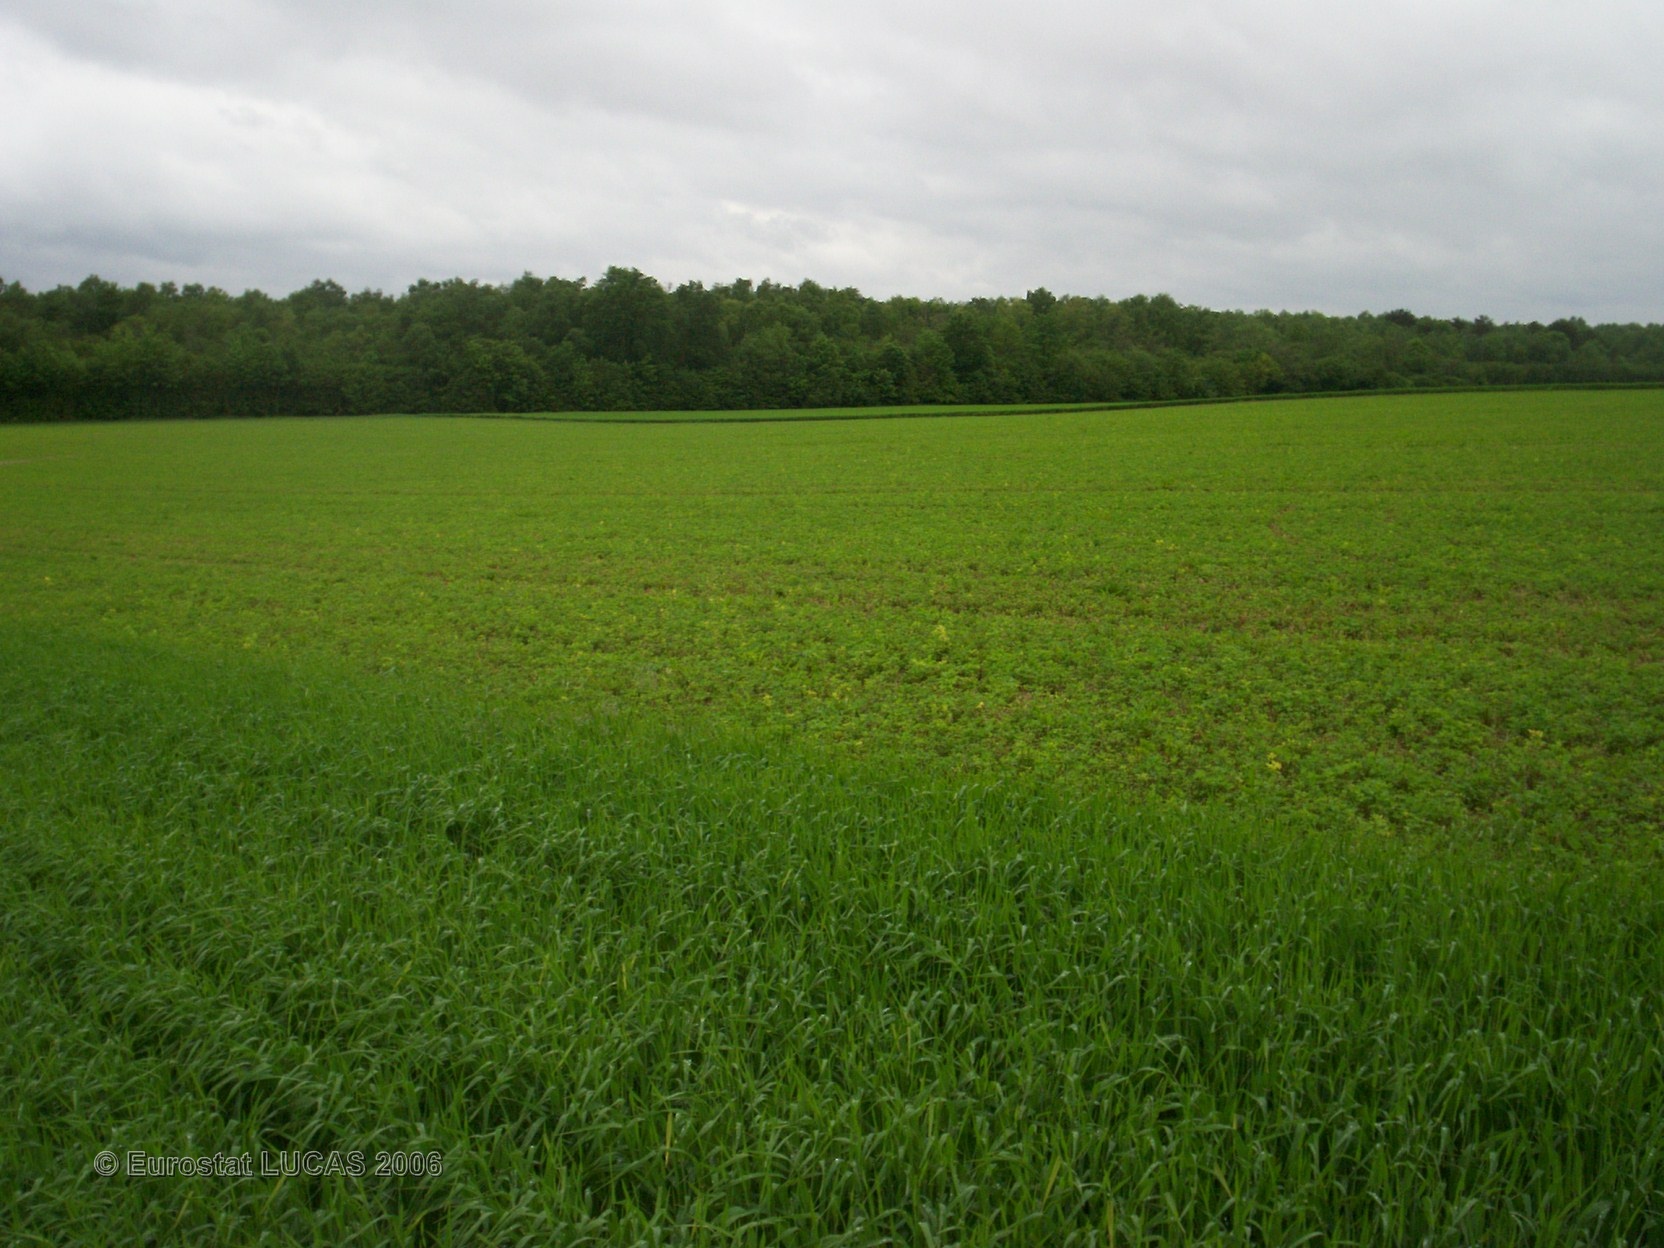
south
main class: Cropland
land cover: Barley
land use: Agriculture (excluding fallow land and kitchen gardens)
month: May
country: FR
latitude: 49.3281
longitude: 4.4511
